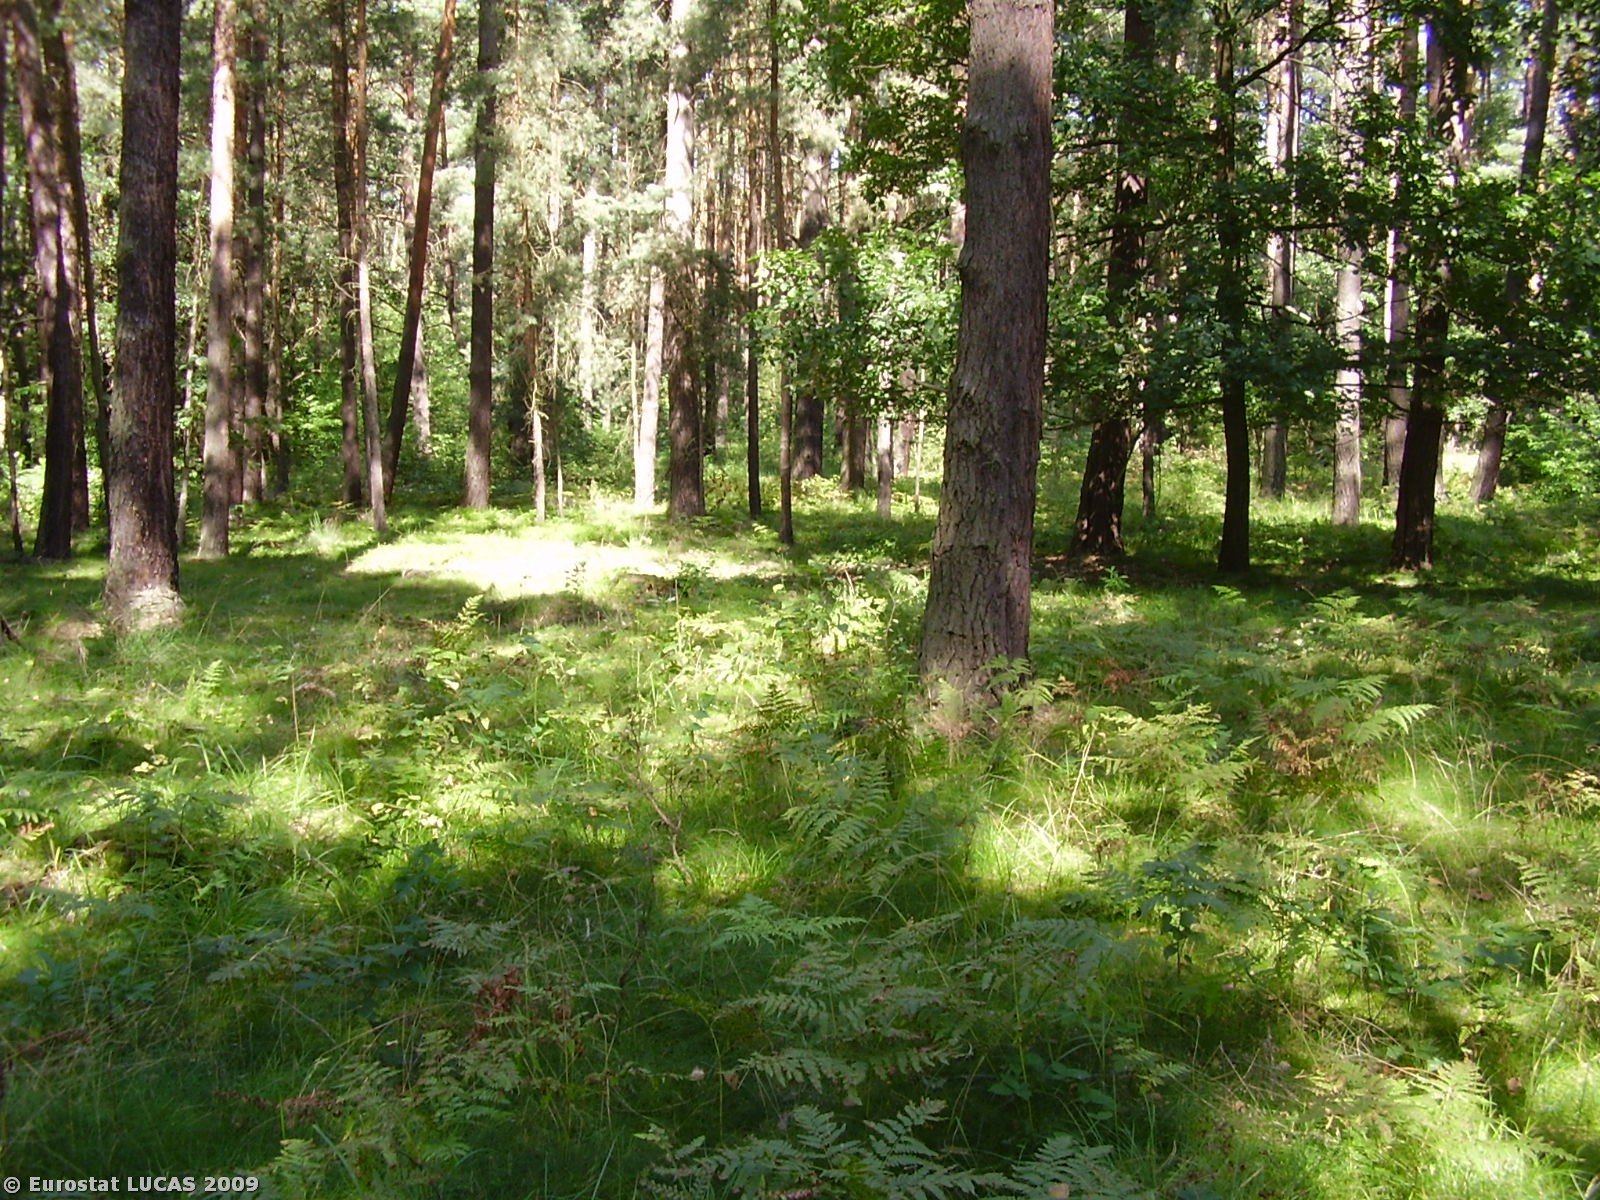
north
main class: Woodland
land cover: Mixed woodland
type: hemiboreal forest and nemoral coniferous forest and mixed broadleaved-coniferous forest
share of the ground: > 75 %
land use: Forestry
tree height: > 5 m
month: August
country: PL
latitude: 51.3369
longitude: 16.1068
